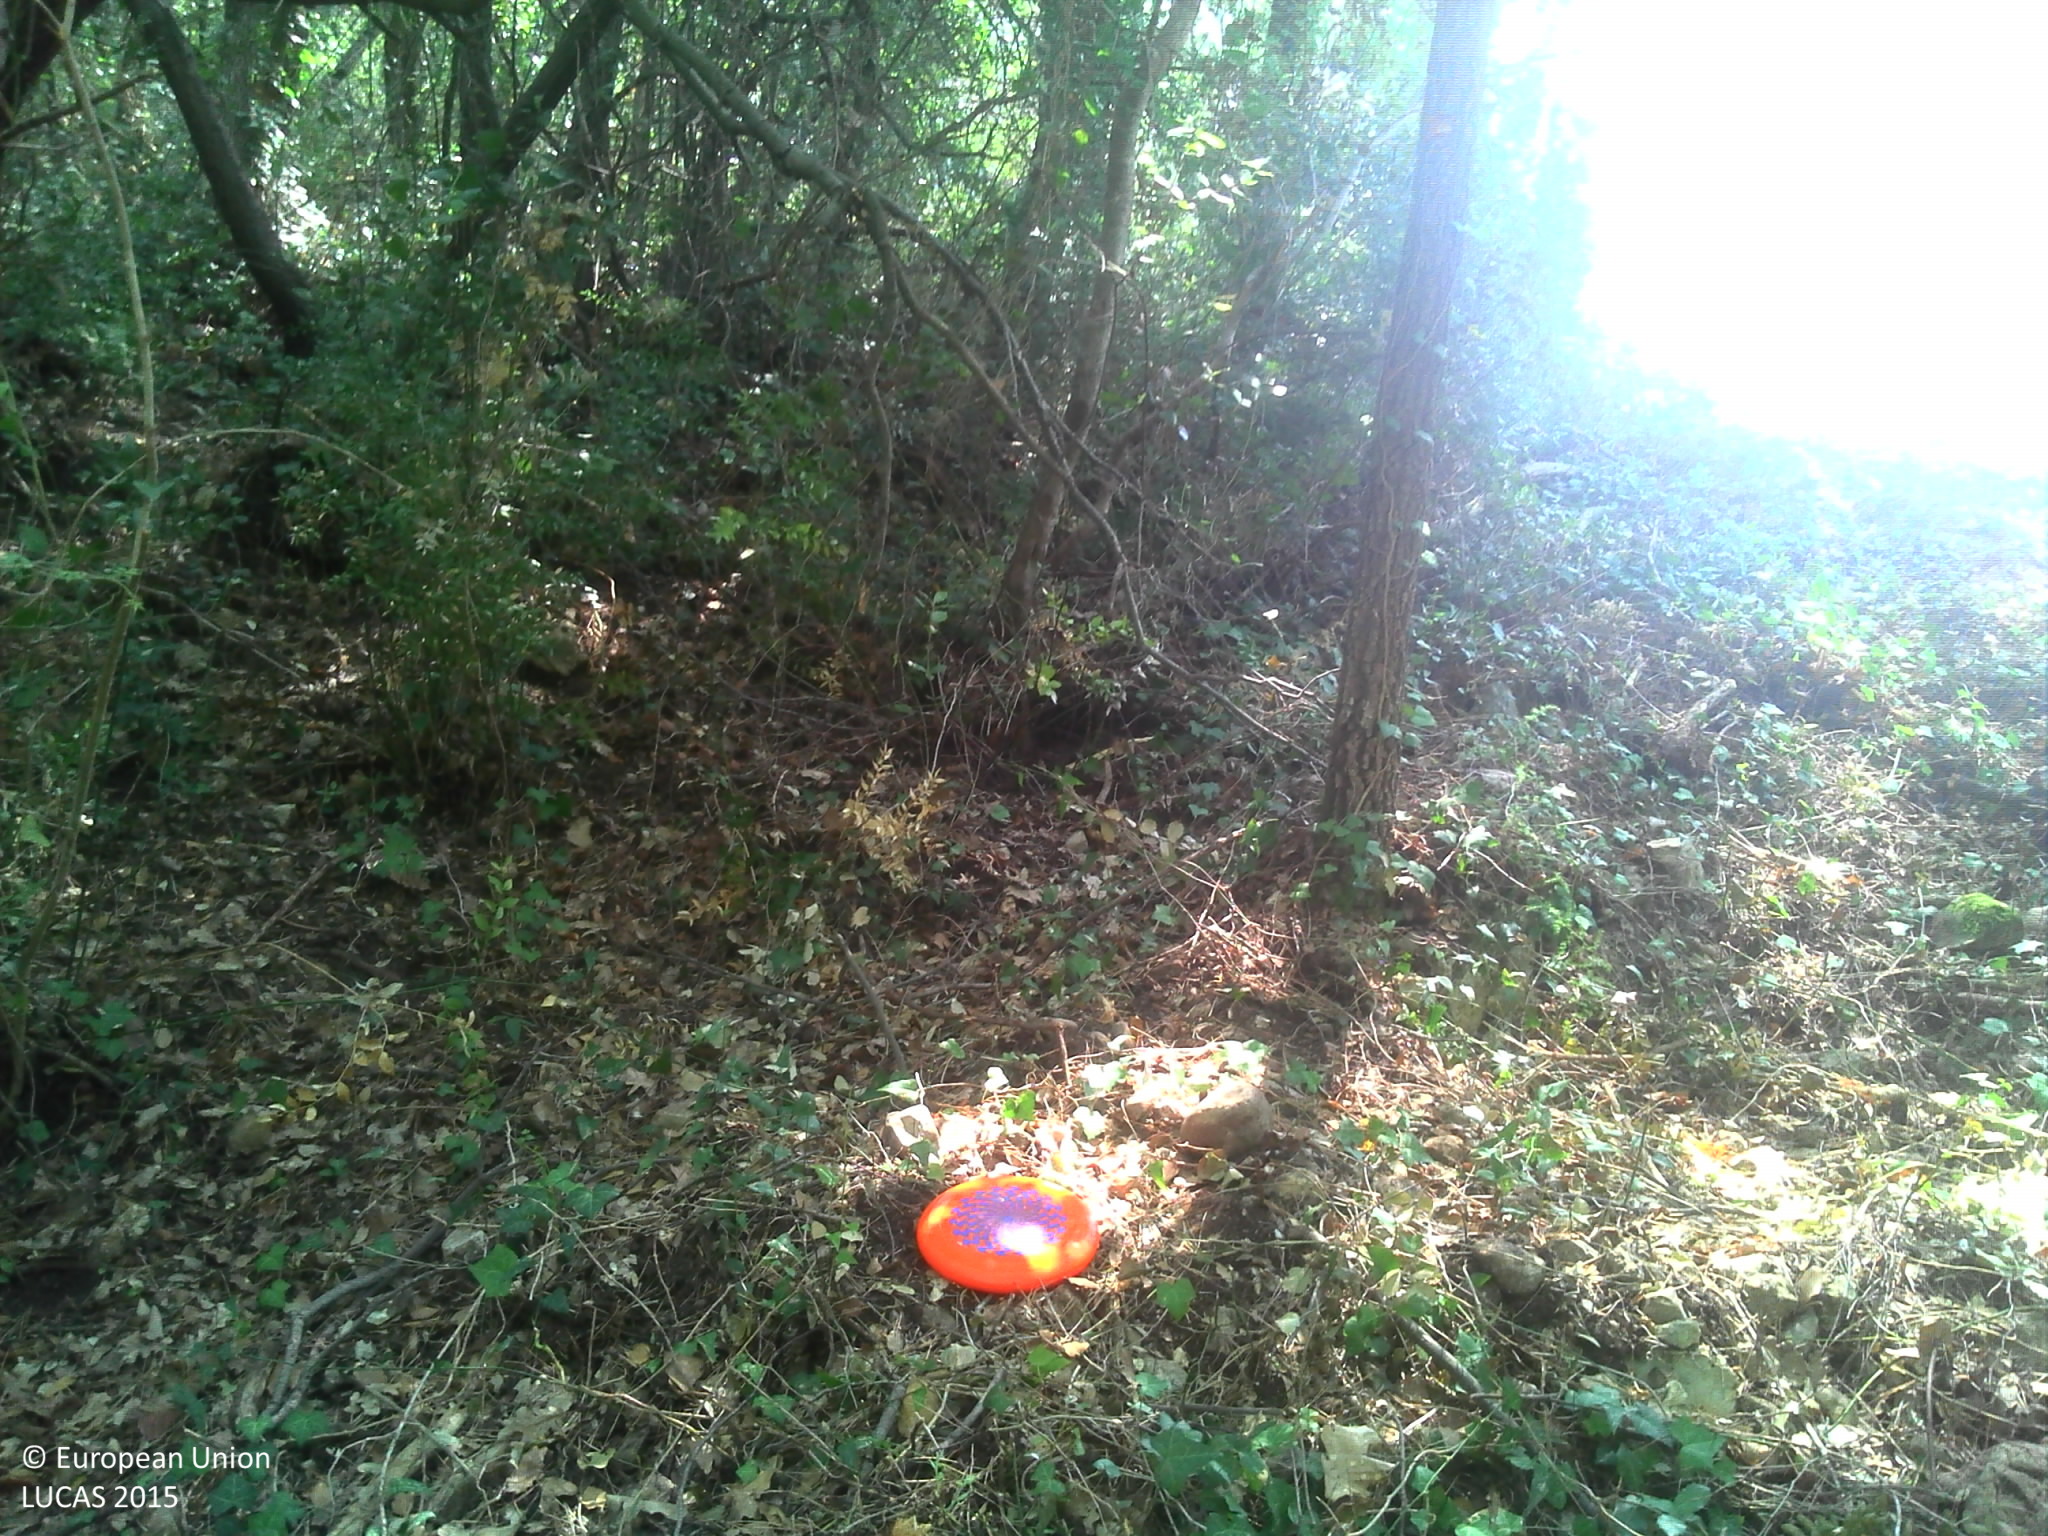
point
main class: Woodland
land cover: Pine dominated mixed woodland
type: broadleaved evergreen forest
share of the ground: > 75 %
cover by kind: coniferous forest trees 50 %, broadleaved forest trees 30 %, unconsolidated bare surface 10 %
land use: Semi-natural and natural areas not in use
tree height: > 5 m
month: July
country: FR
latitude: 43.3994
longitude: 6.2926
